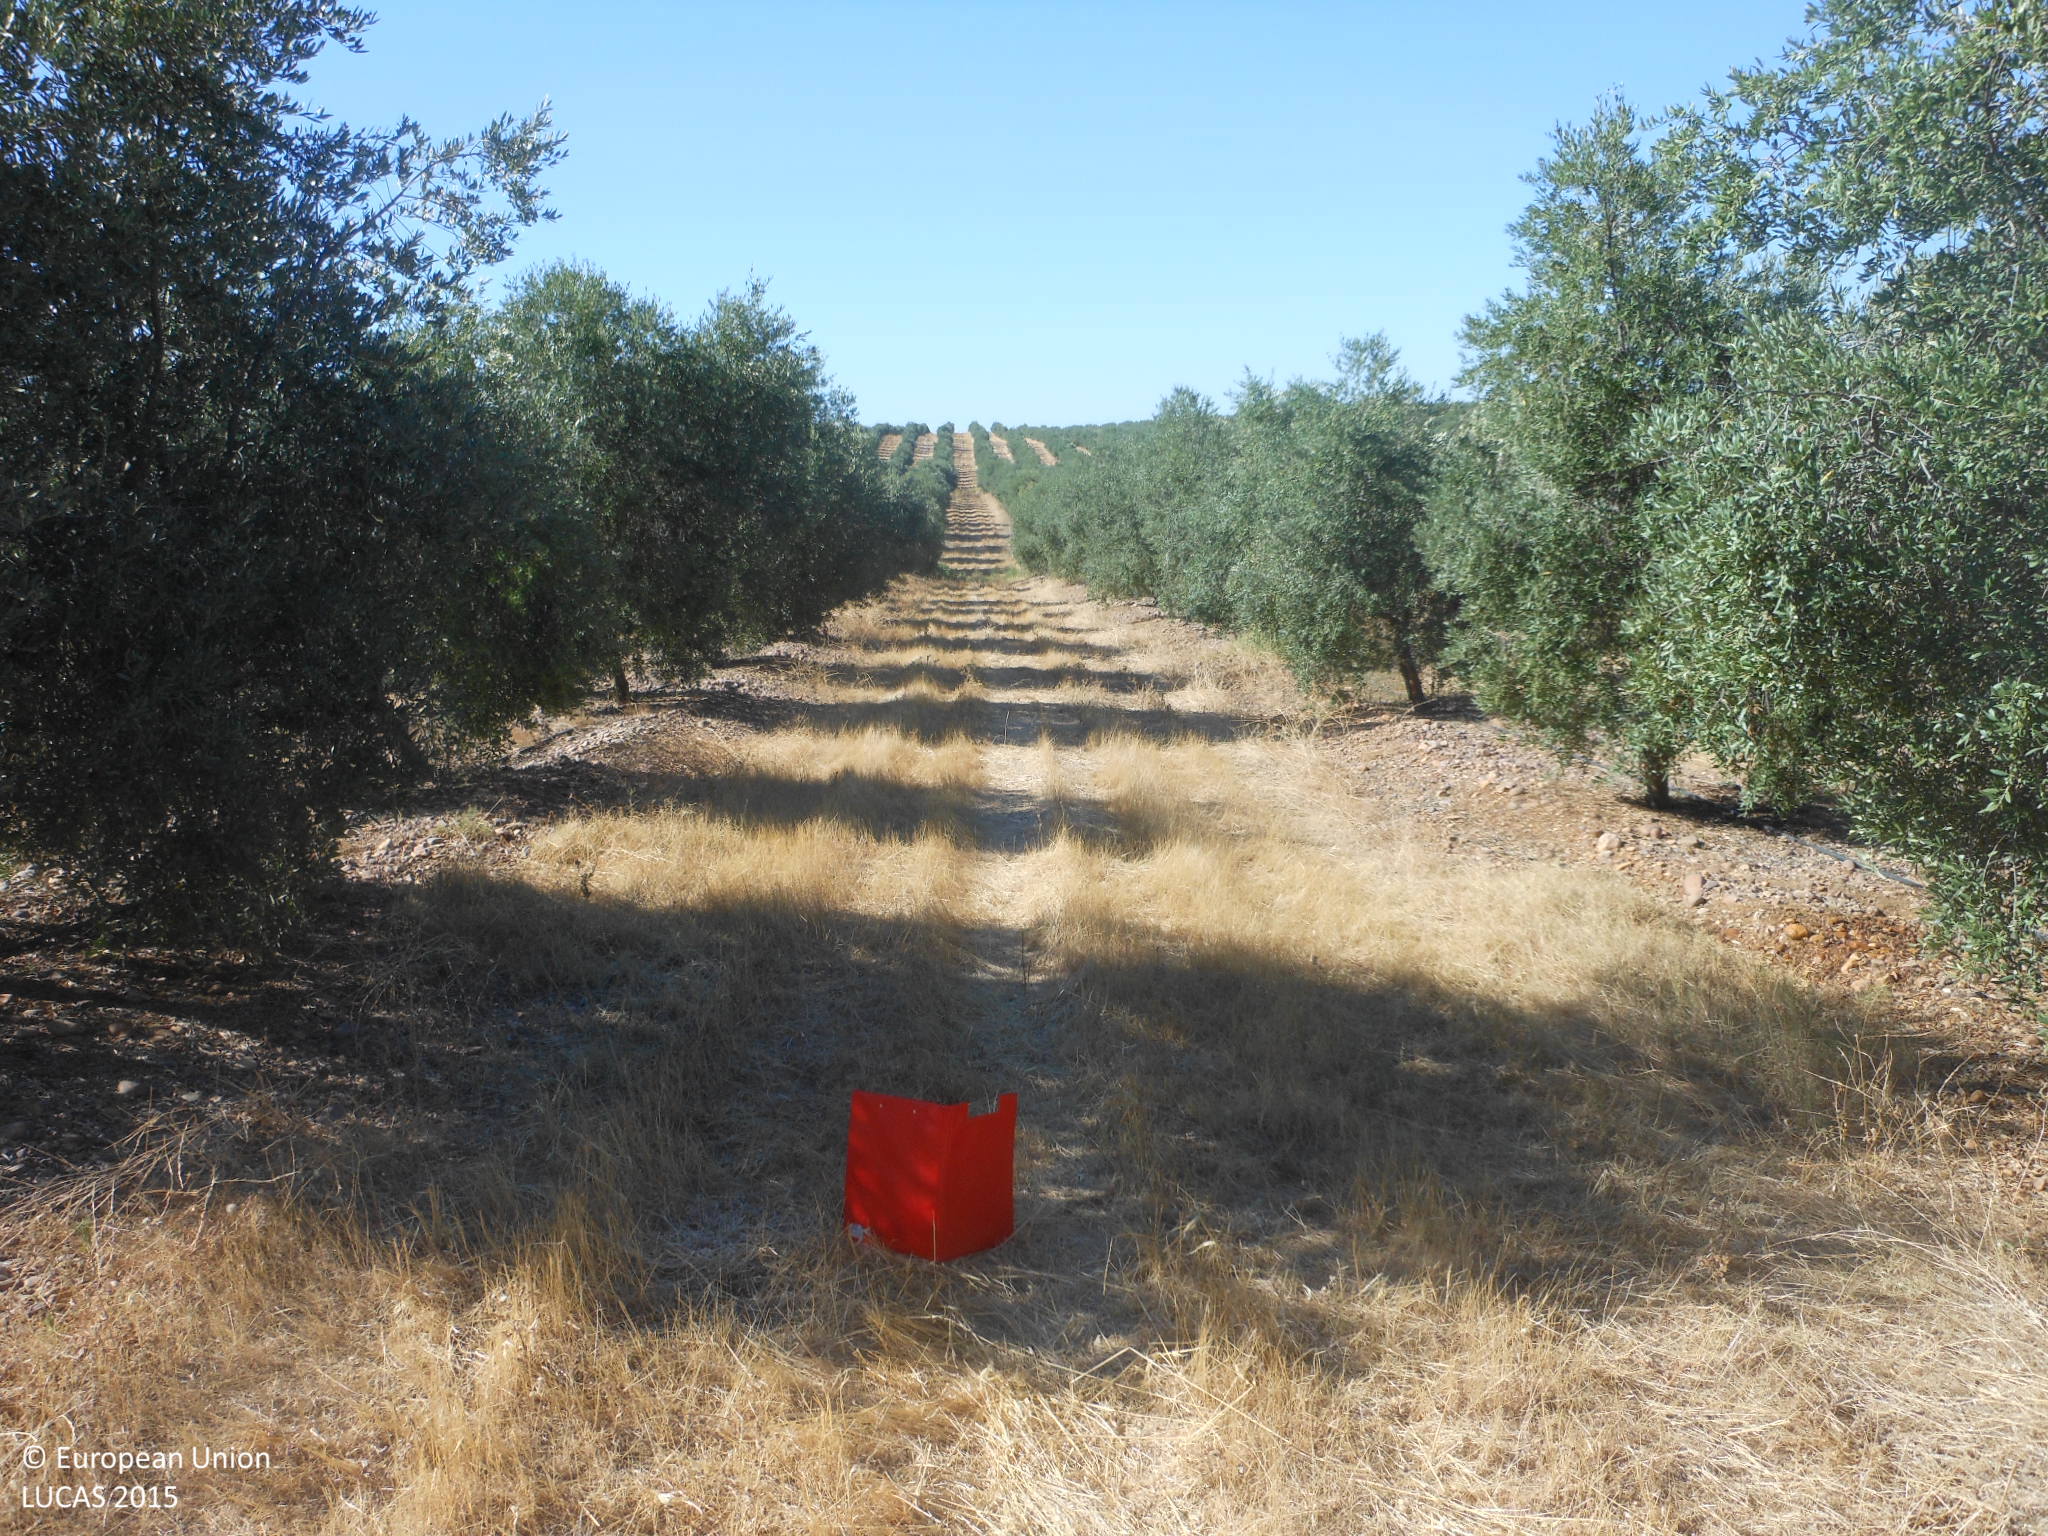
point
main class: Cropland
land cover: Olive groves
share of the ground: 25 - 50 %
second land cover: Spontaneously vegetated surfaces
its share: 50 - 75 %
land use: Agriculture (excluding fallow land and kitchen gardens)
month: July
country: ES
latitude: 37.5843
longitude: -5.5458
